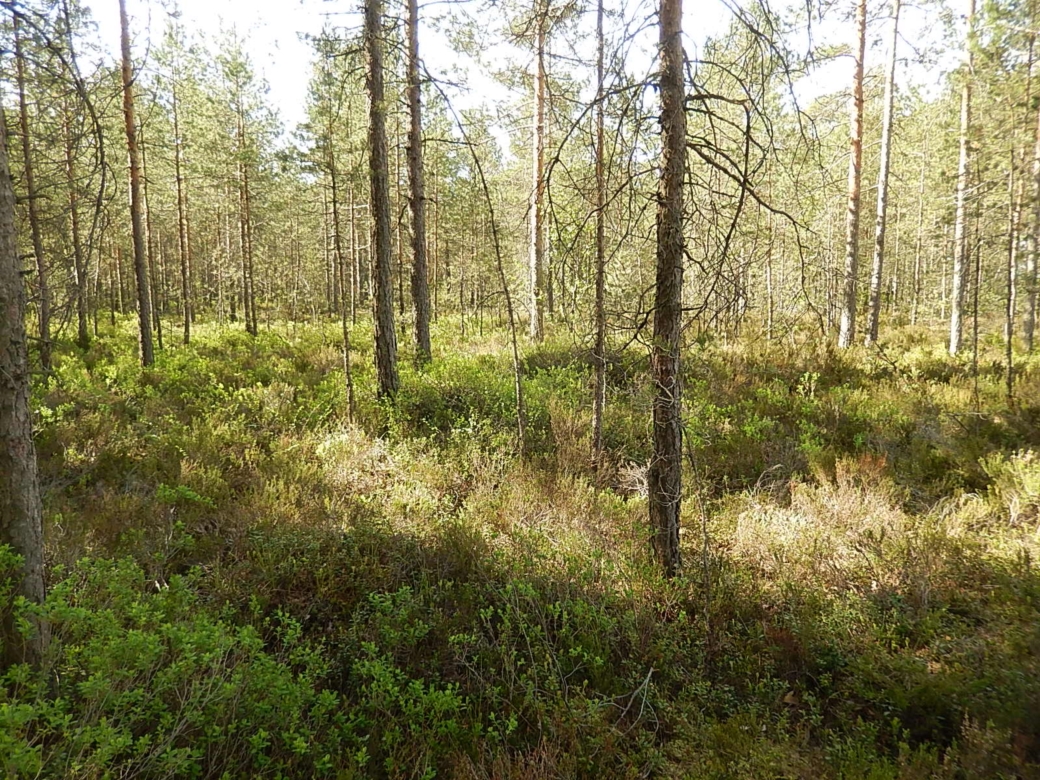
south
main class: Woodland
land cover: Pine dominated coniferous woodland
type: boreal forest
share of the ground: > 75 %
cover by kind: coniferous forest trees 75 %, shrubs 15 %, broadleaved forest trees 10 %
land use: Forestry
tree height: > 5 m
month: June
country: FI
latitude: 61.9789
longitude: 22.2876
